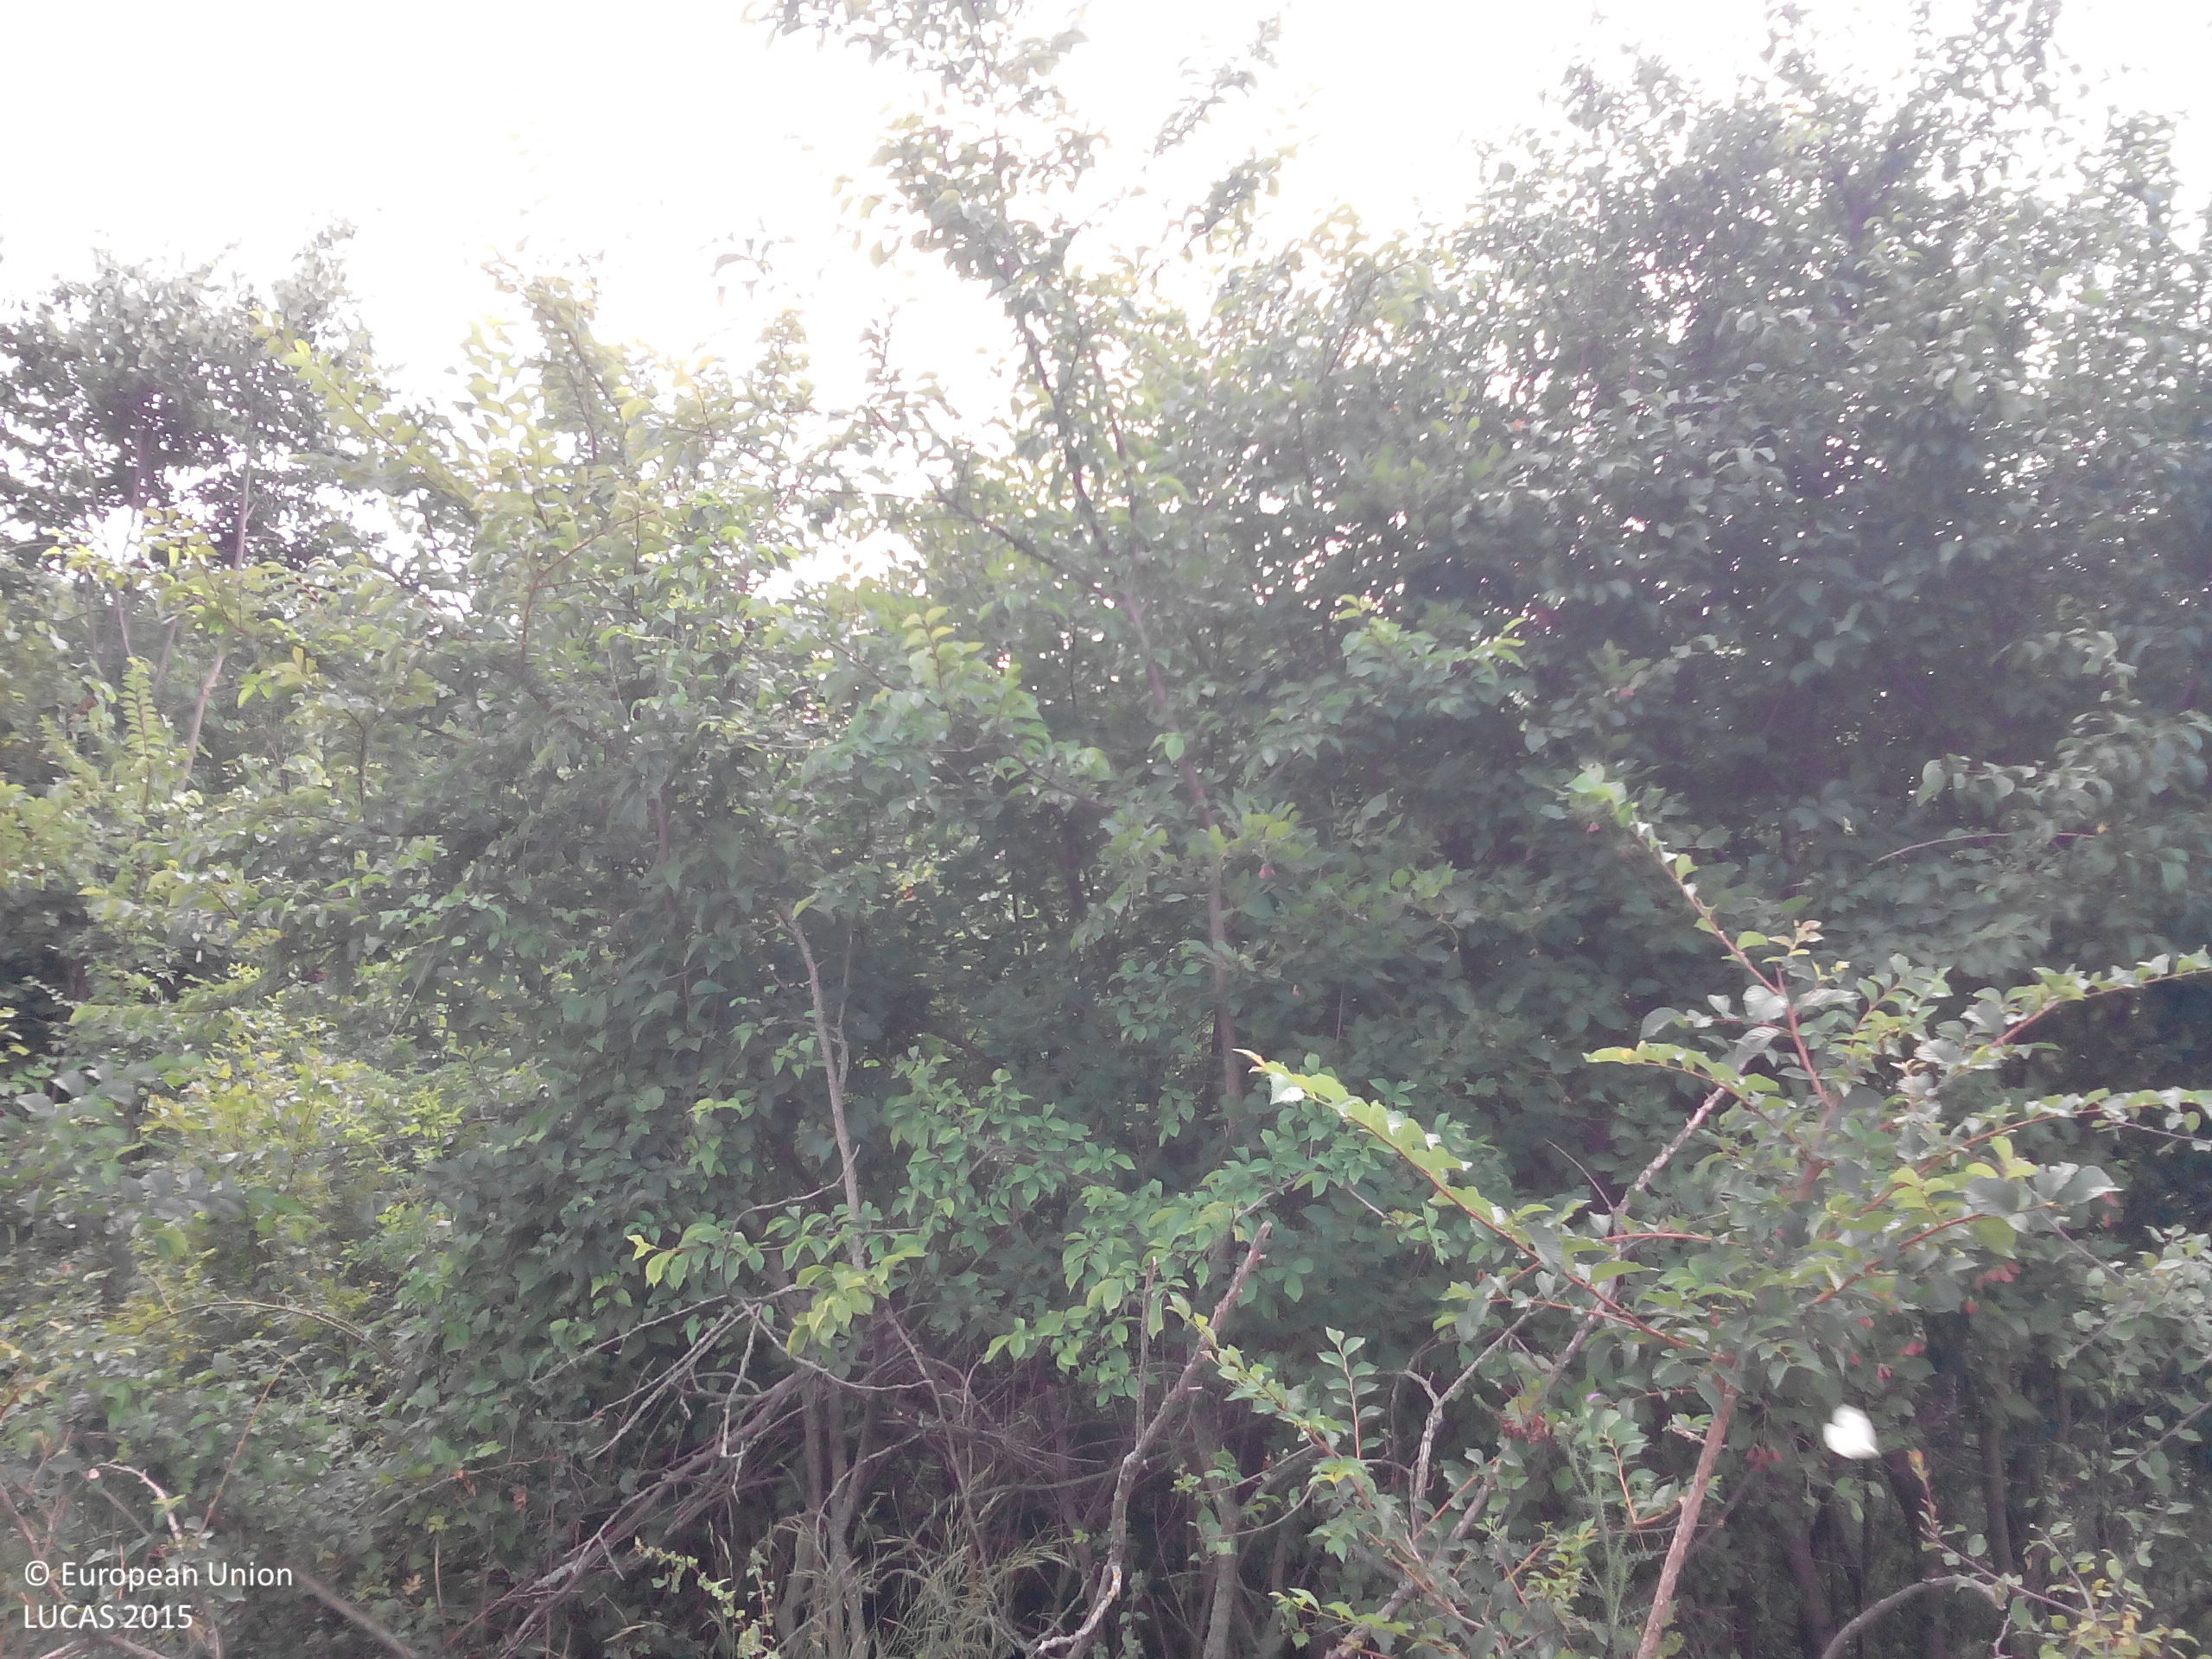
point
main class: Woodland
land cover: Broadleaved woodland
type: mesophytic deciduous forest
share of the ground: > 75 %
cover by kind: broadleaved forest trees 90 %, shrubs 5 %, herbaceous plants 5 %
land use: Forestry
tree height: > 5 m
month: July
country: BG
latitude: 43.3669
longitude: 24.2095
